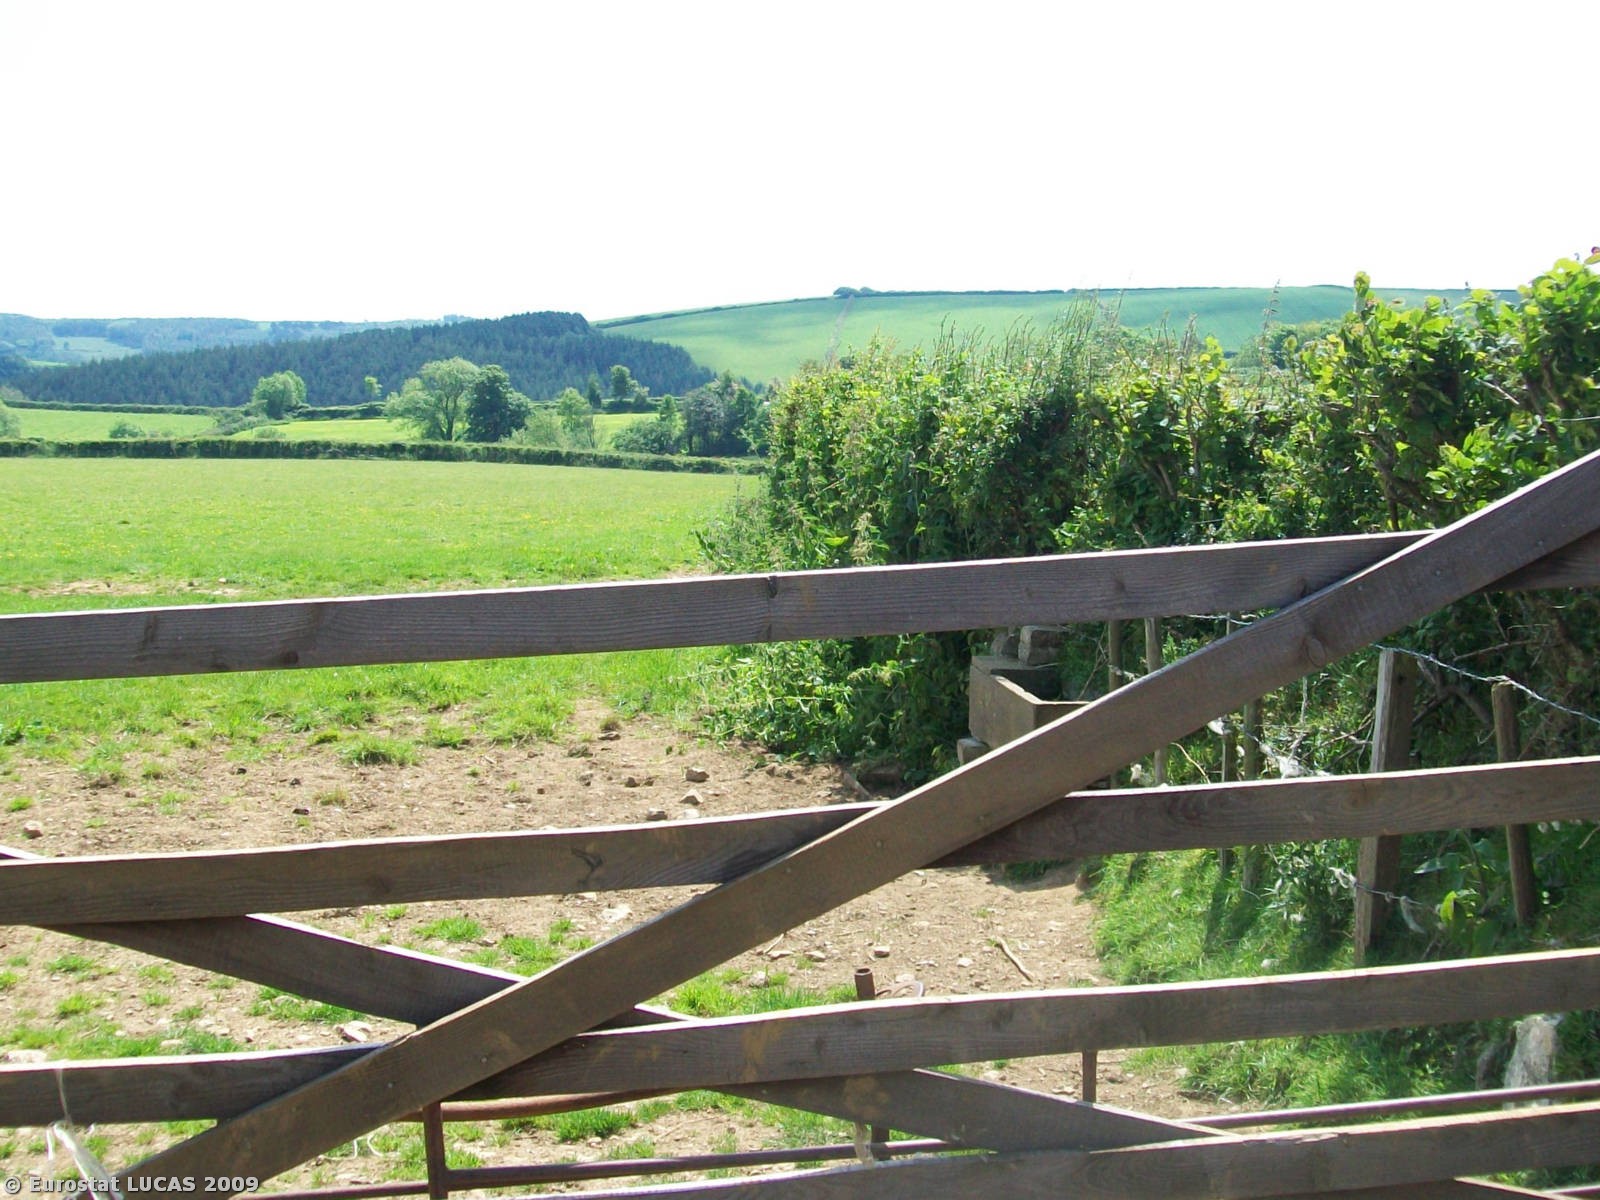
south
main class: Cropland
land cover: Barley
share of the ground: > 75 %
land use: Agriculture (excluding fallow land and kitchen gardens)
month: June
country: GB
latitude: 50.4798
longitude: -4.6078
